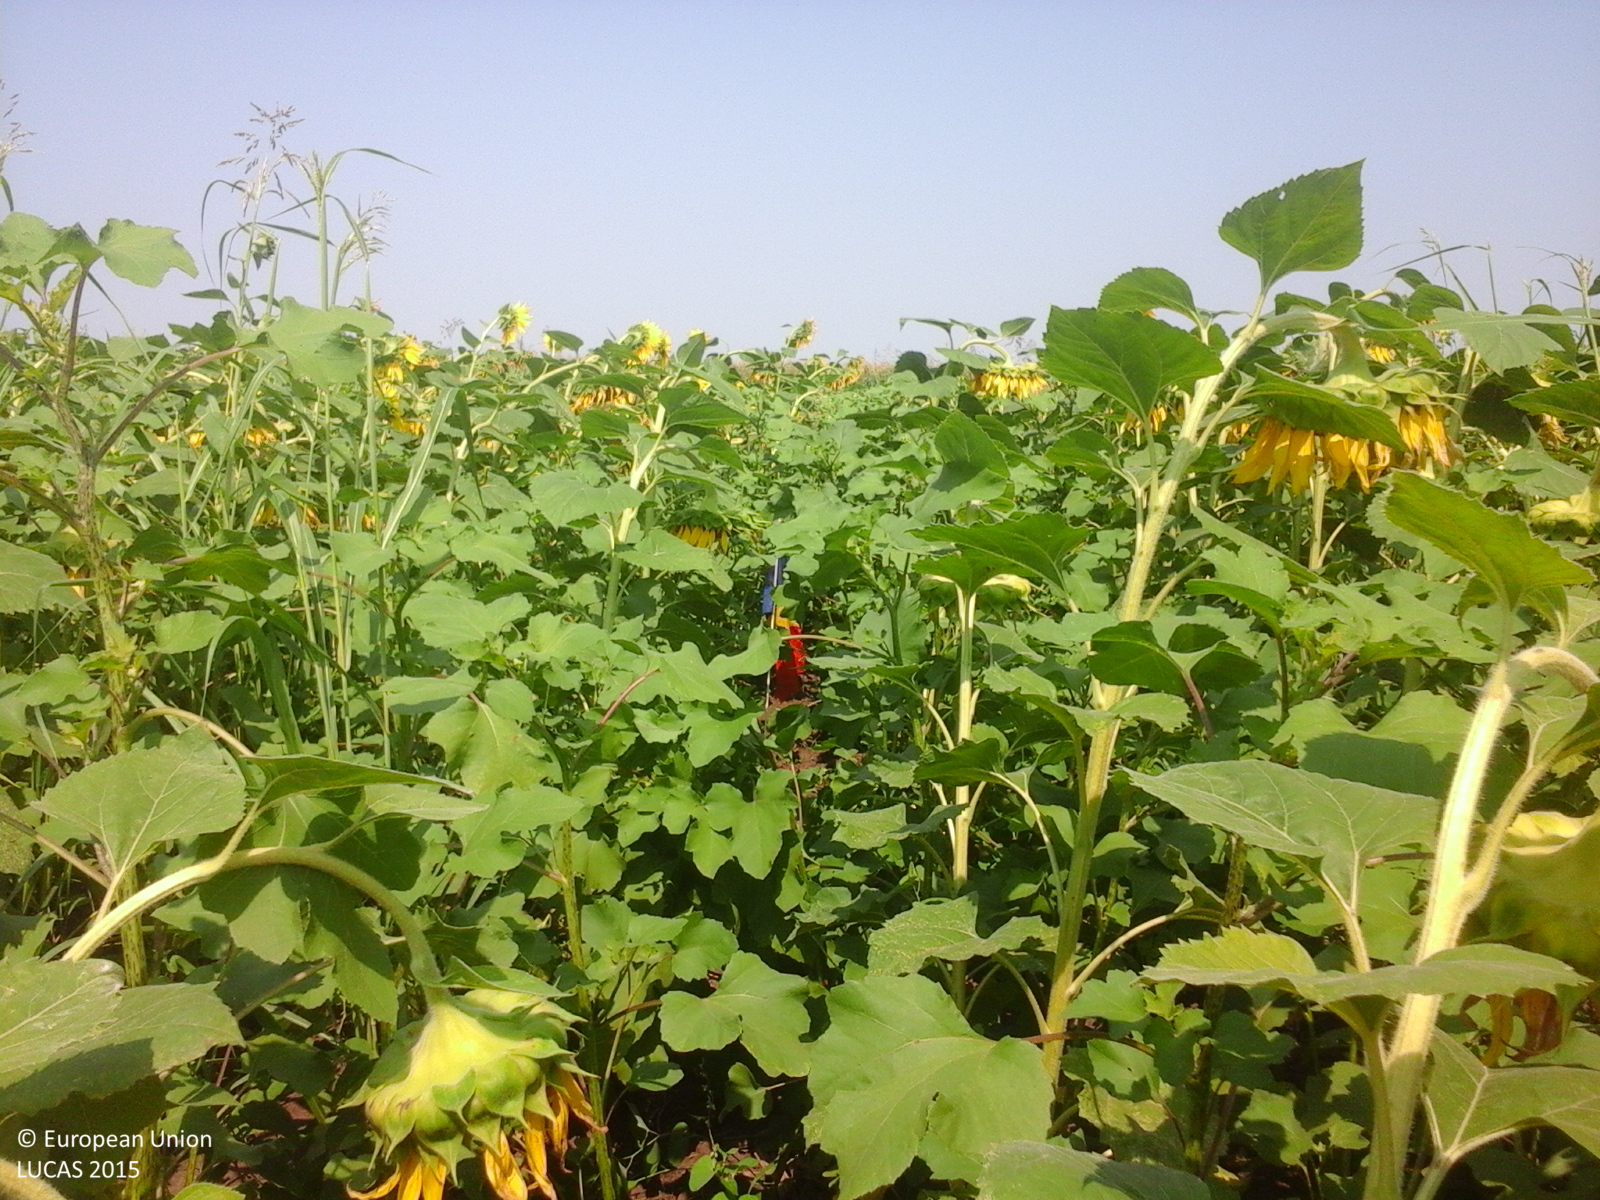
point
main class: Cropland
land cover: Sunflower
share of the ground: > 75 %
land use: Agriculture (excluding fallow land and kitchen gardens)
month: July
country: RO
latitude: 44.8854
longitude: 26.7756
